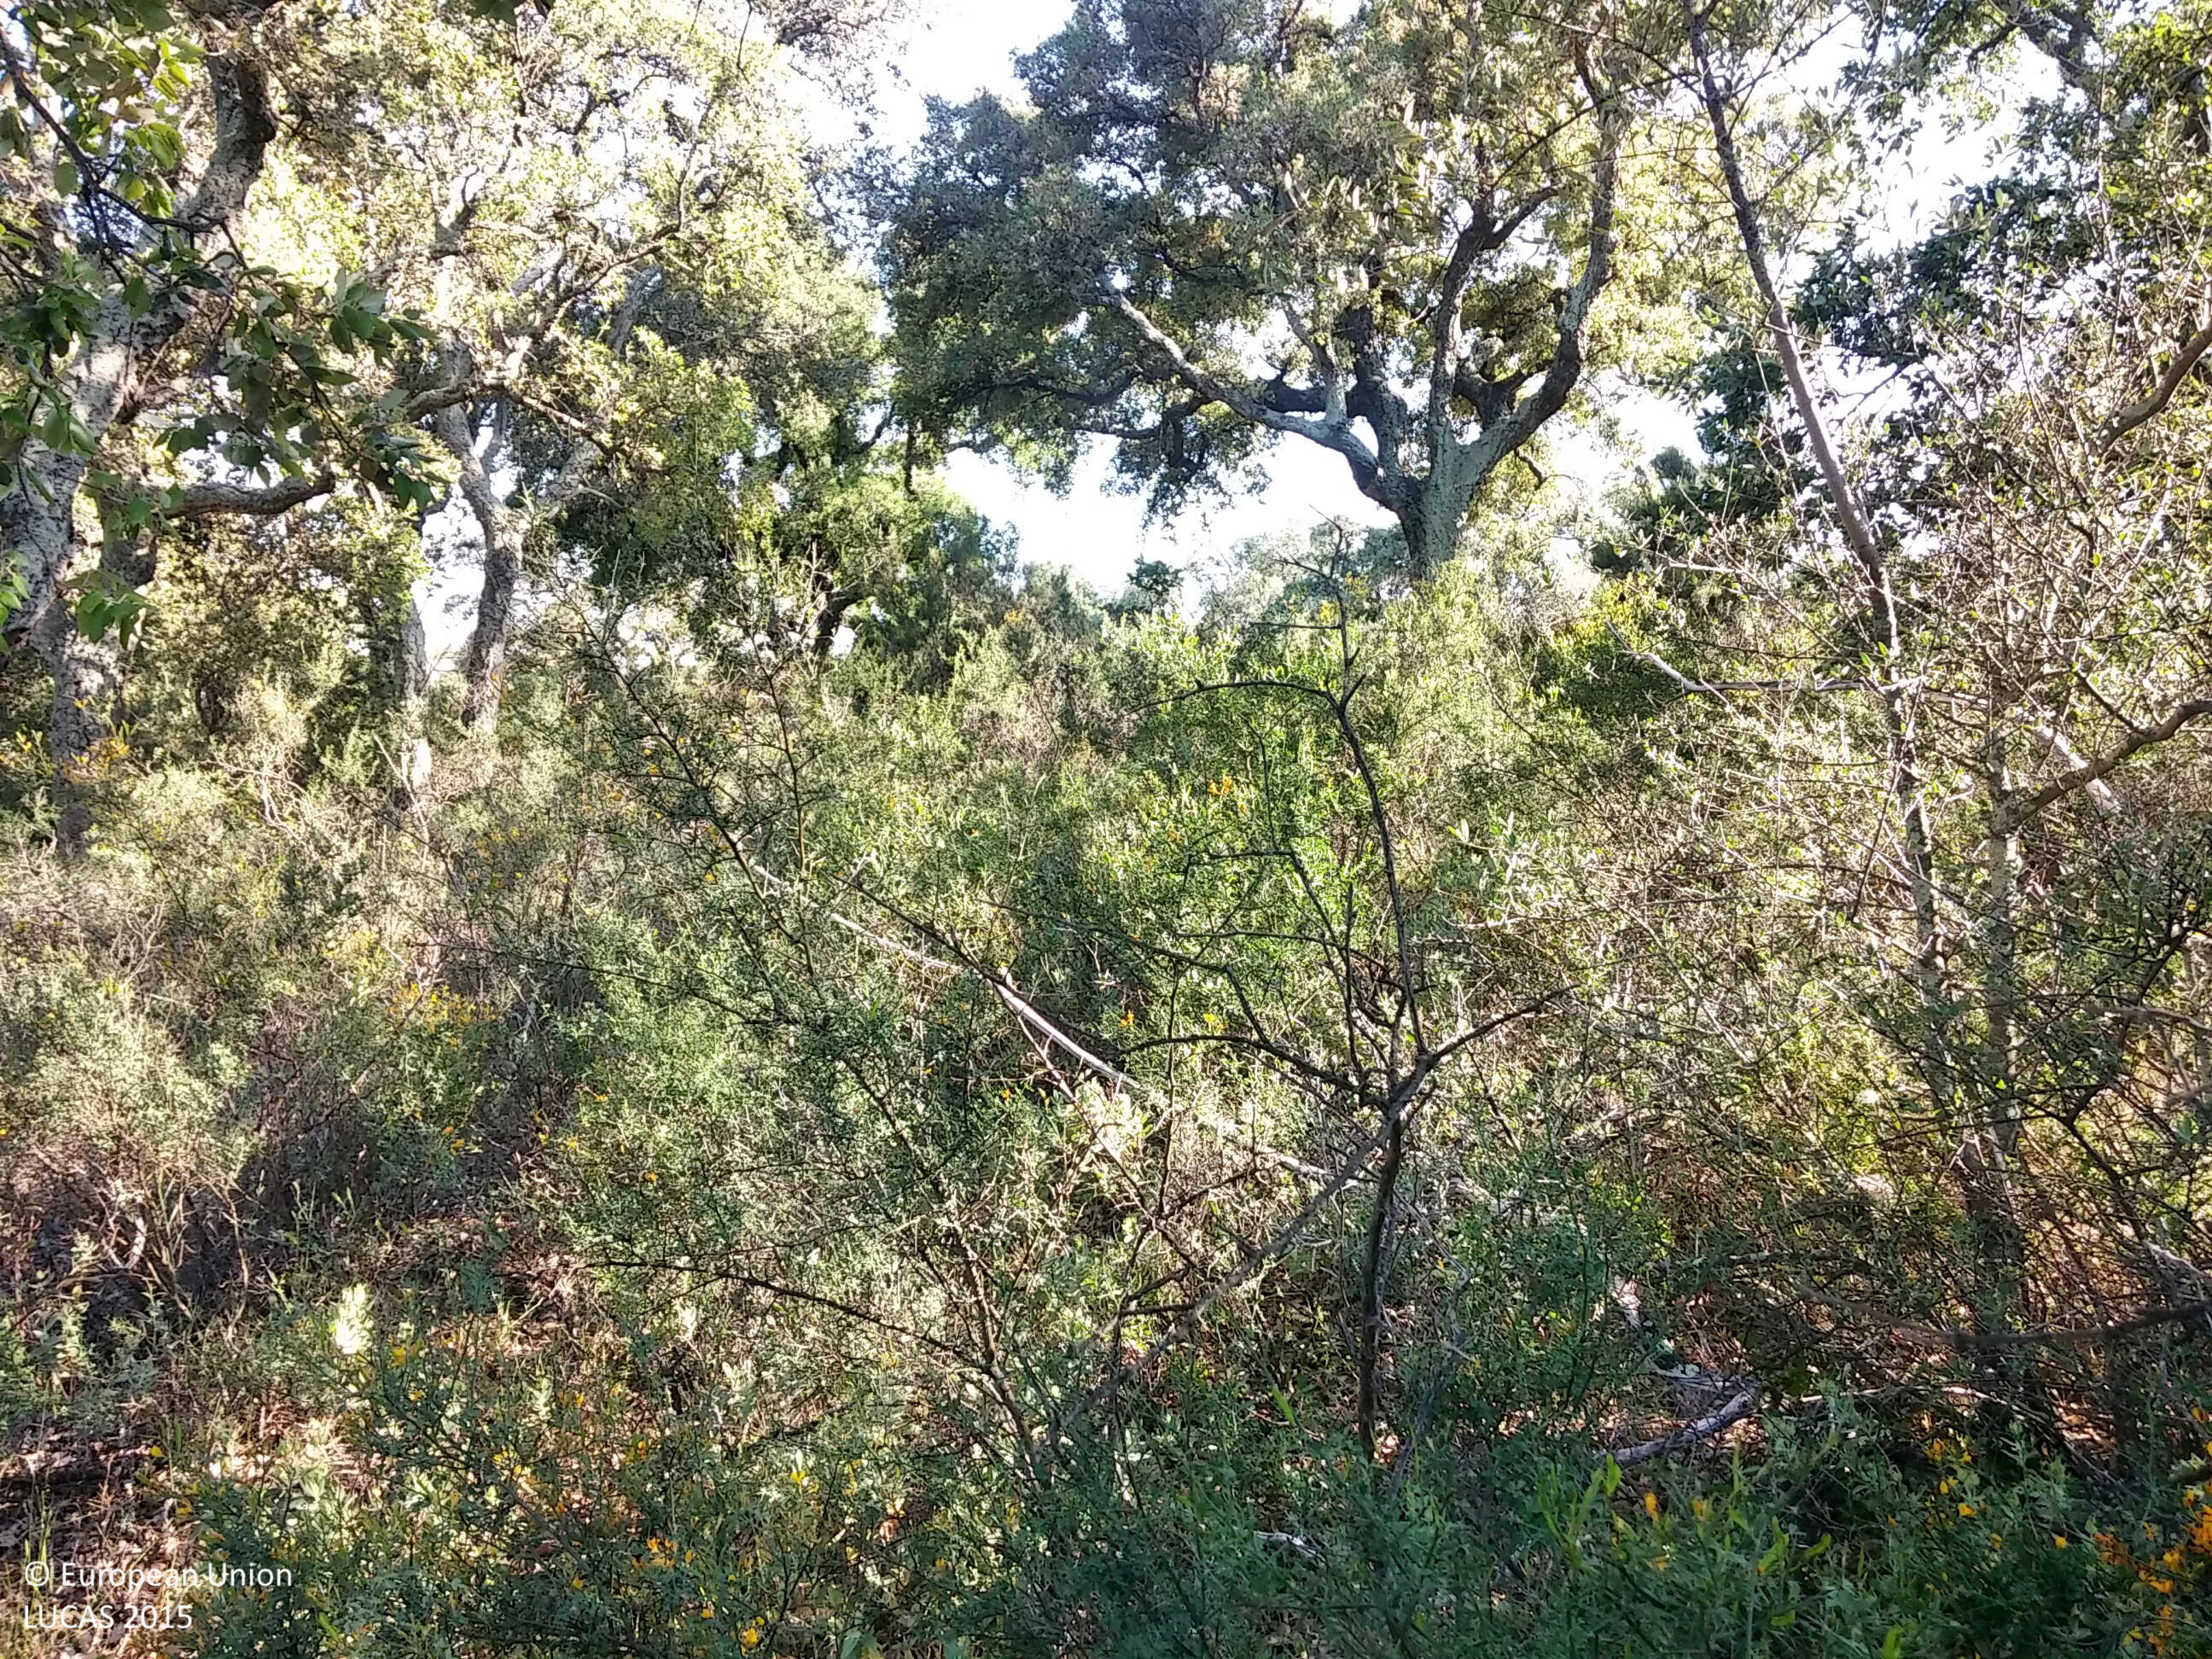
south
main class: Woodland
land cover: Broadleaved woodland
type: thermophilous deciduous forest
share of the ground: 25 - 50 %
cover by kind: shrubs 50 %, broadleaved forest trees 35 %, herbaceous plants 15 %
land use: Forestry
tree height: > 5 m
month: May
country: ES
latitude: 42.3972
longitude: 3.0525
